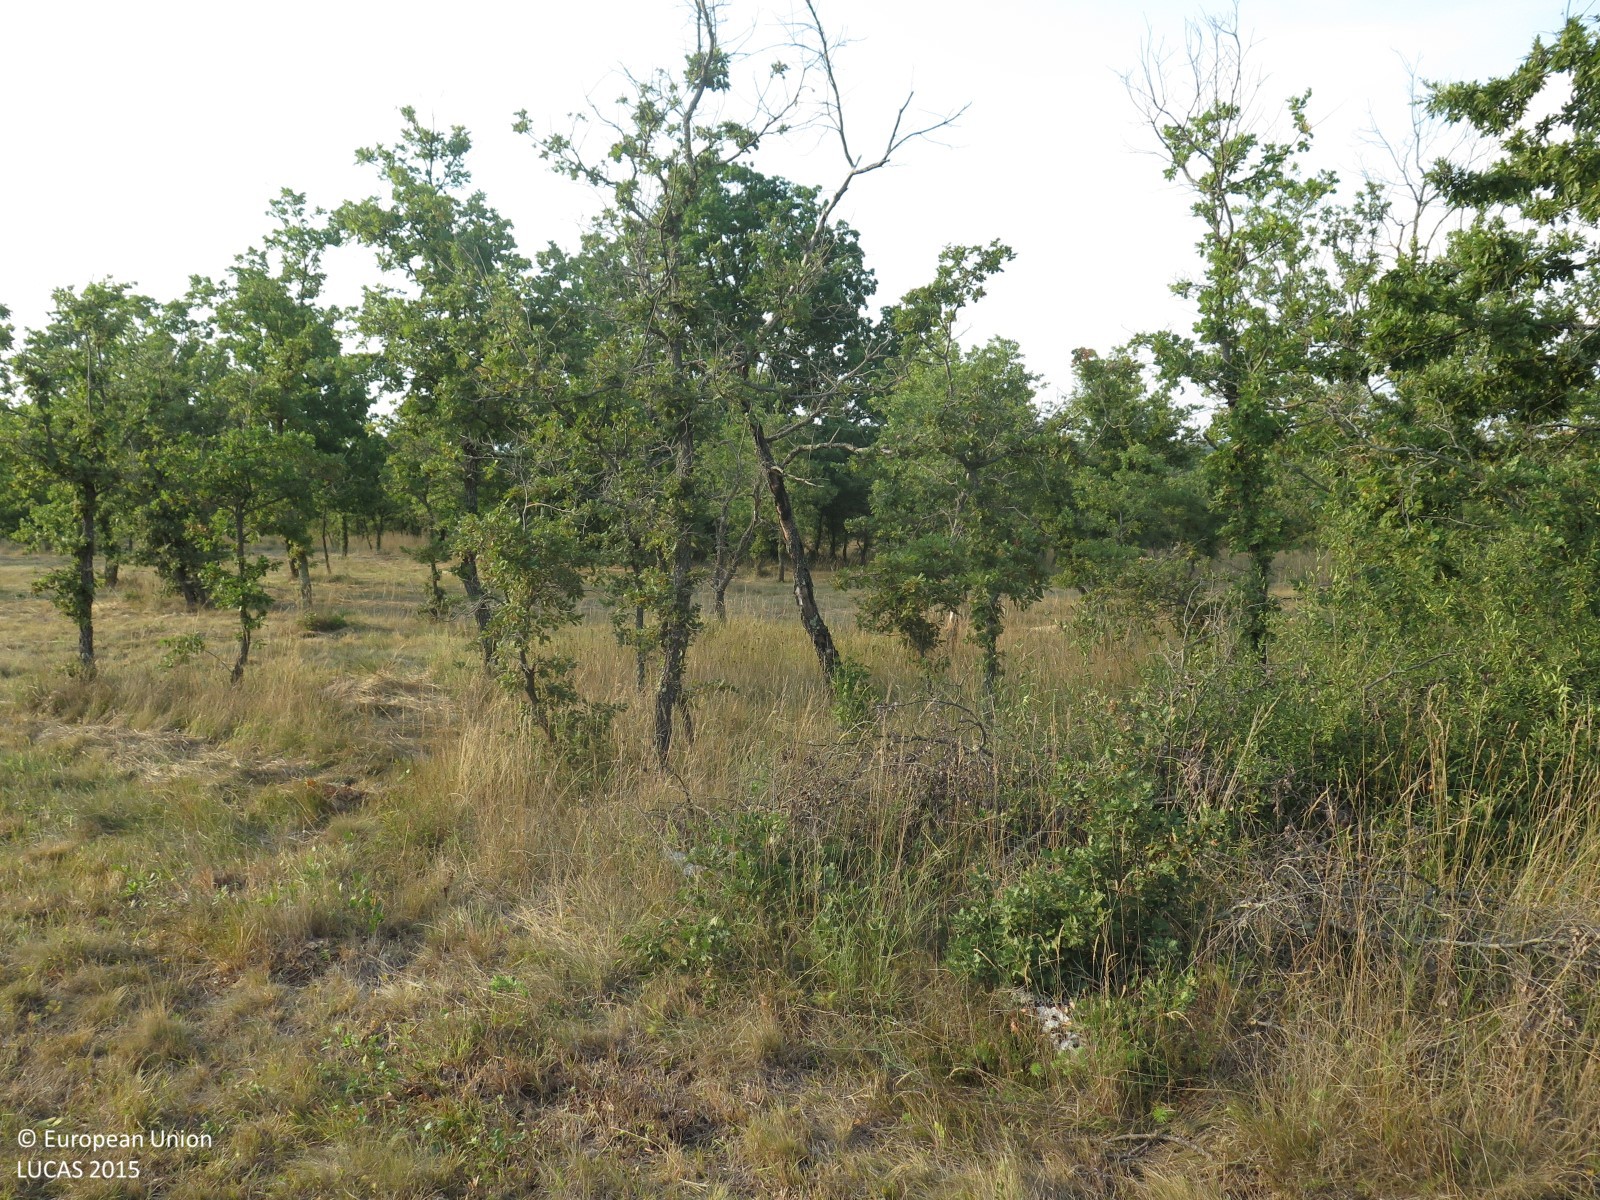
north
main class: Grassland
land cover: Grassland with sparse tree/shrub cover
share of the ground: > 75 %
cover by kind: herbaceous plants 85 %, shrubs 10 %, broadleaved forest trees 5 %
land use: Semi-natural and natural areas not in use
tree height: < 5 m
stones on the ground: < 10 %
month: July
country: HR
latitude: 45.2573
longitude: 13.7541
